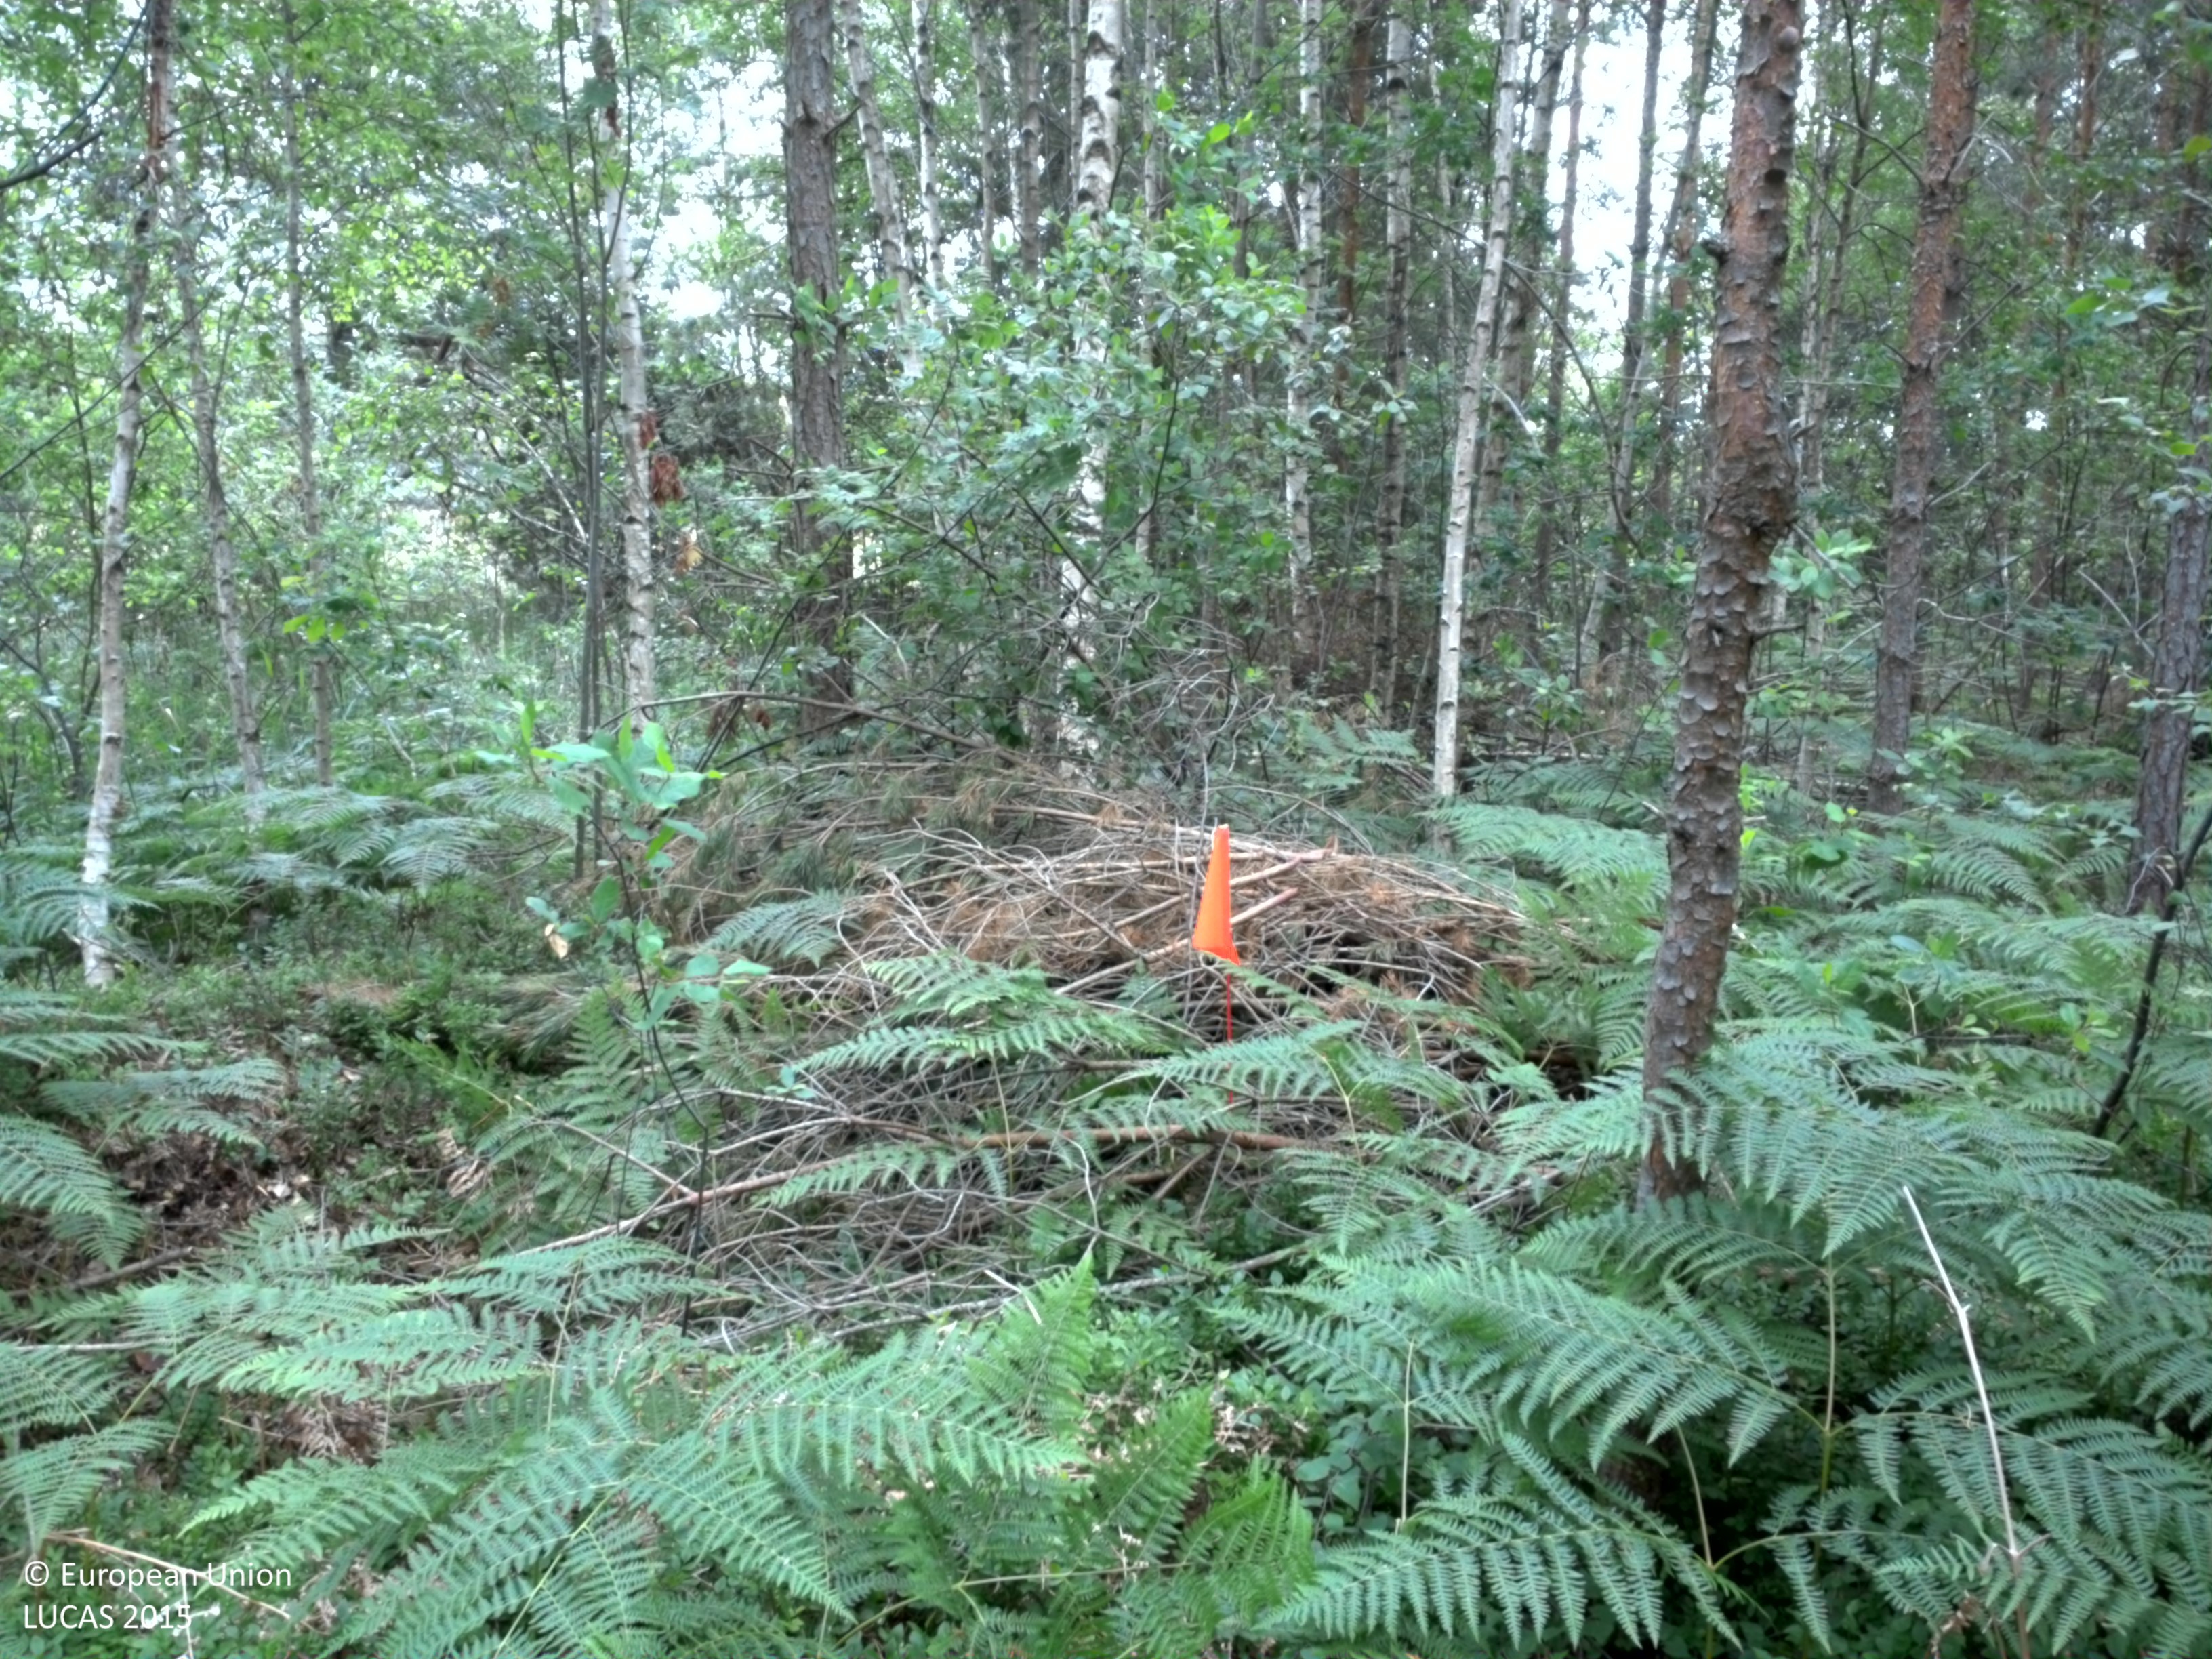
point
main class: Woodland
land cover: Pine dominated mixed woodland
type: hemiboreal forest and nemoral coniferous forest and mixed broadleaved-coniferous forest
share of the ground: > 75 %
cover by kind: coniferous forest trees 55 %, broadleaved forest trees 25 %, shrubs 15 %, herbaceous plants 5 %
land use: Forestry
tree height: > 5 m
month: July
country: SE
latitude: 57.4765
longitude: 18.2621
